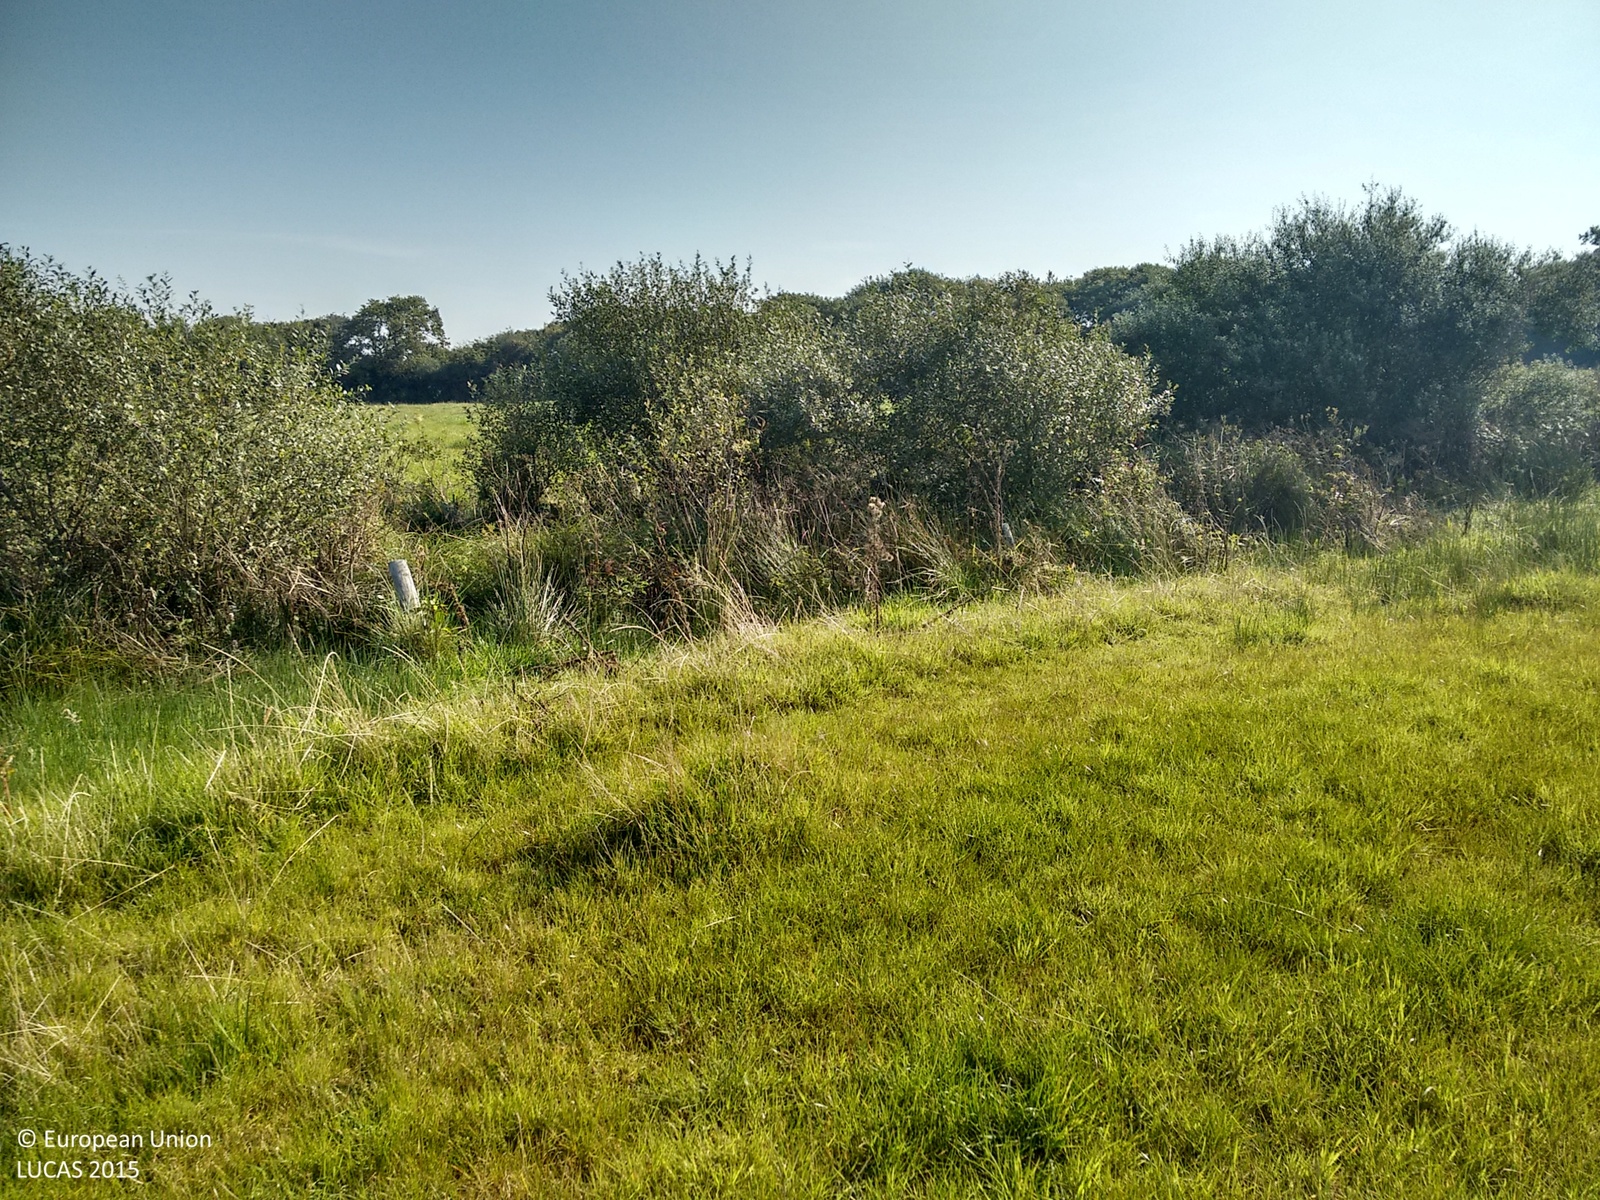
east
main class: Grassland
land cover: Grassland without tree/shrub cover
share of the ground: > 75 %
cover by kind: herbaceous plants 100 %
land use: Agriculture (excluding fallow land and kitchen gardens)
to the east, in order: Grassland without tree/shrub cover; Shrubland without tree cover; Grassland without tree/shrub cover; Broadleaved woodland; Rivers and streams; Fences; Broadleaved woodland; Grassland without tree/shrub cover
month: September
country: GB
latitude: 50.8140
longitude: -4.4238
